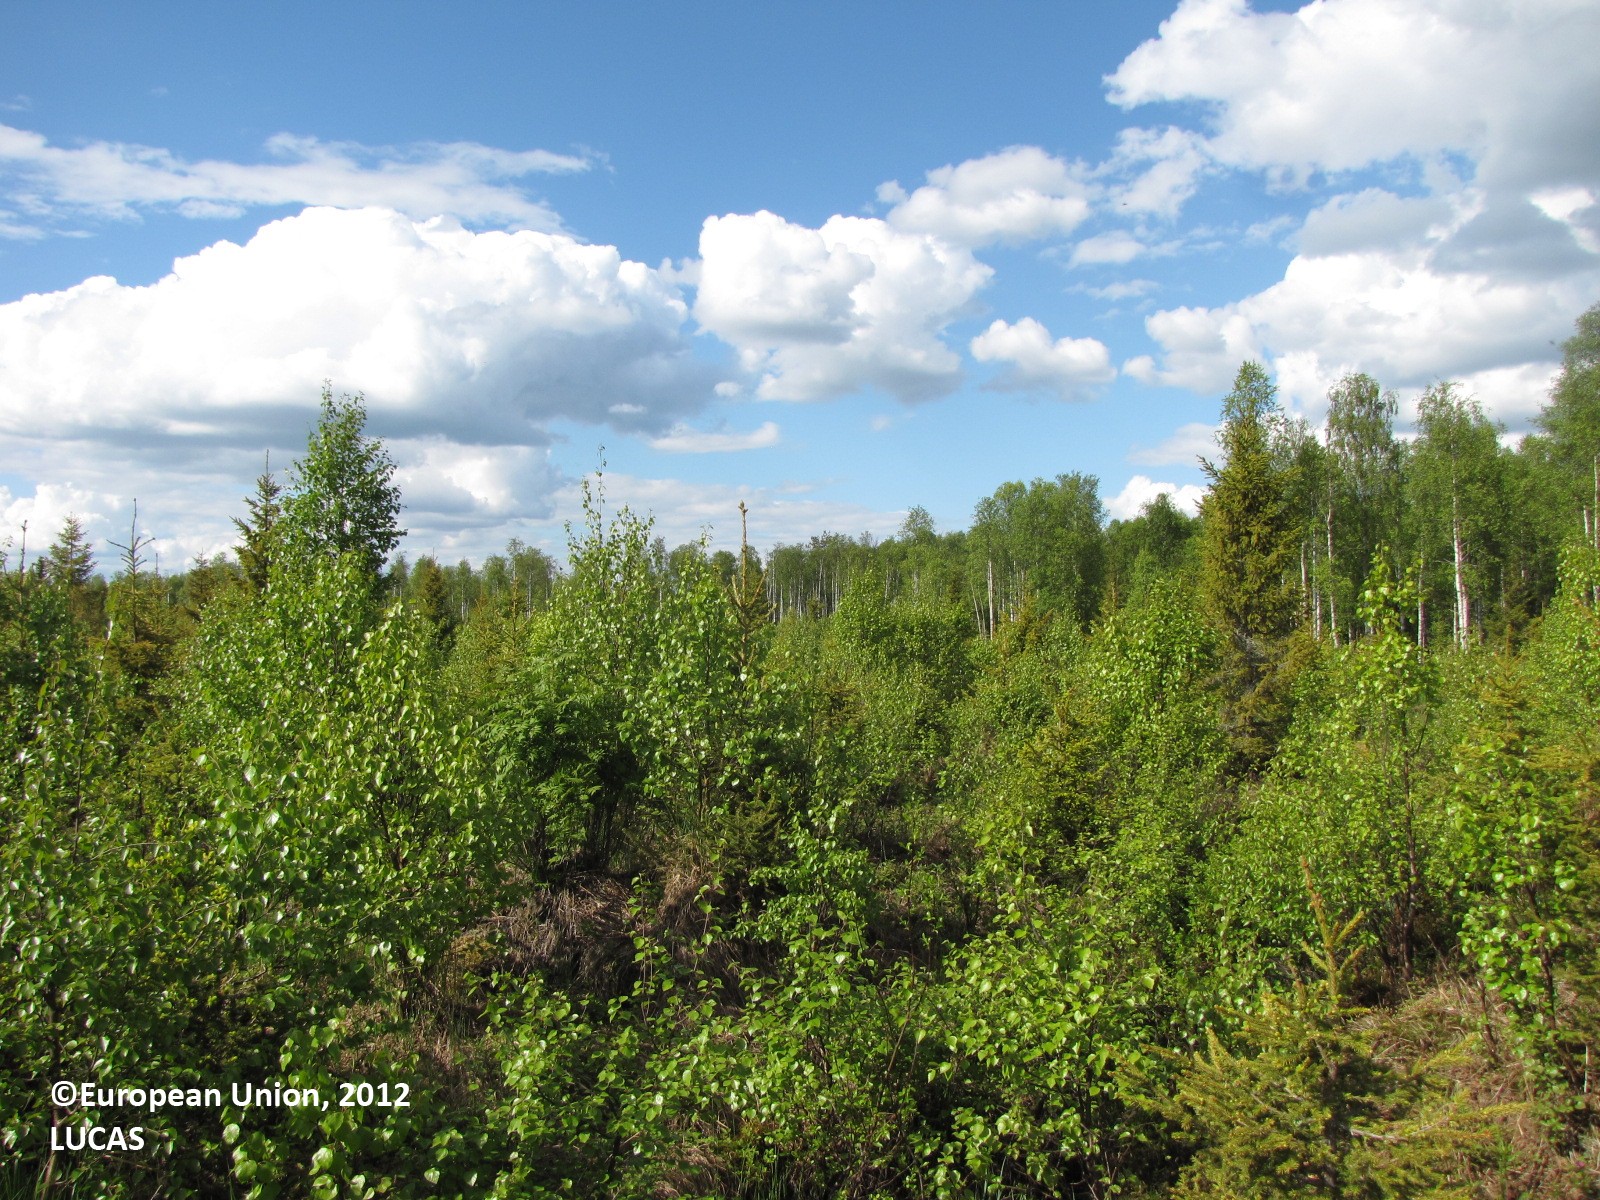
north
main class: Woodland
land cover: Other mixed woodland
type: boreal forest
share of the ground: 50 - 75 %
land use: Forestry
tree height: < 5 m
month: June
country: FI
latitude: 66.0121
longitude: 24.5343
